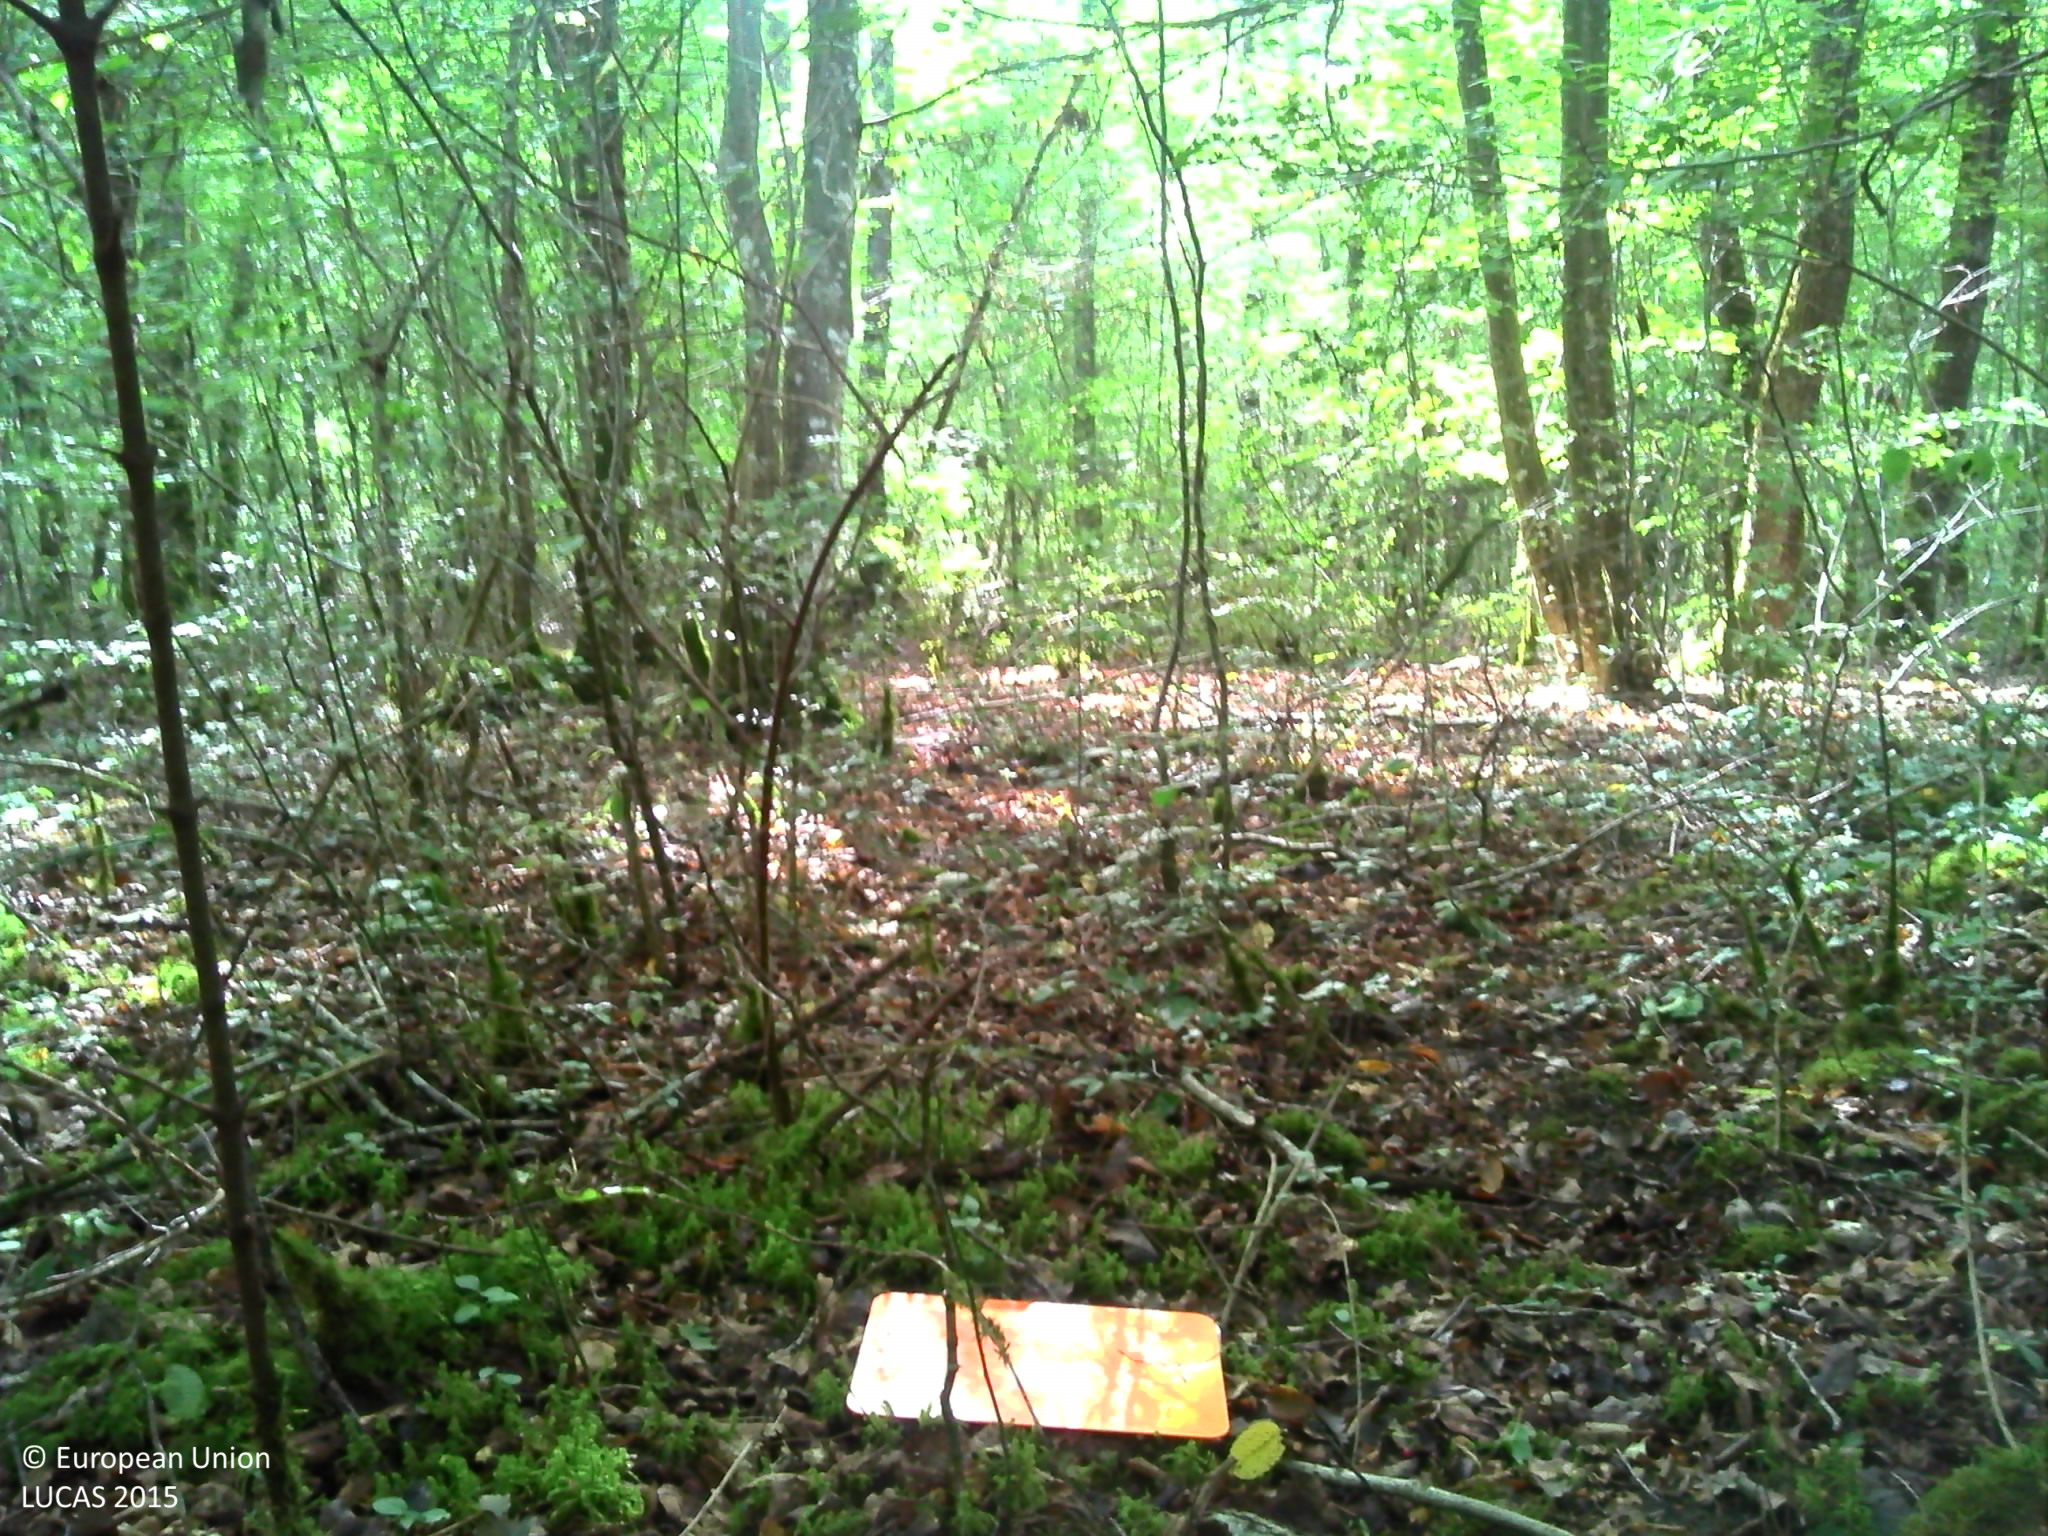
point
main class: Woodland
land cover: Broadleaved woodland
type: mesophytic deciduous forest
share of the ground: > 75 %
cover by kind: broadleaved forest trees 80 %, shrubs 10 %, herbaceous plants 10 %
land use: Forestry
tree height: > 5 m
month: September
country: FR
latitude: 48.2580
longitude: 2.7850
